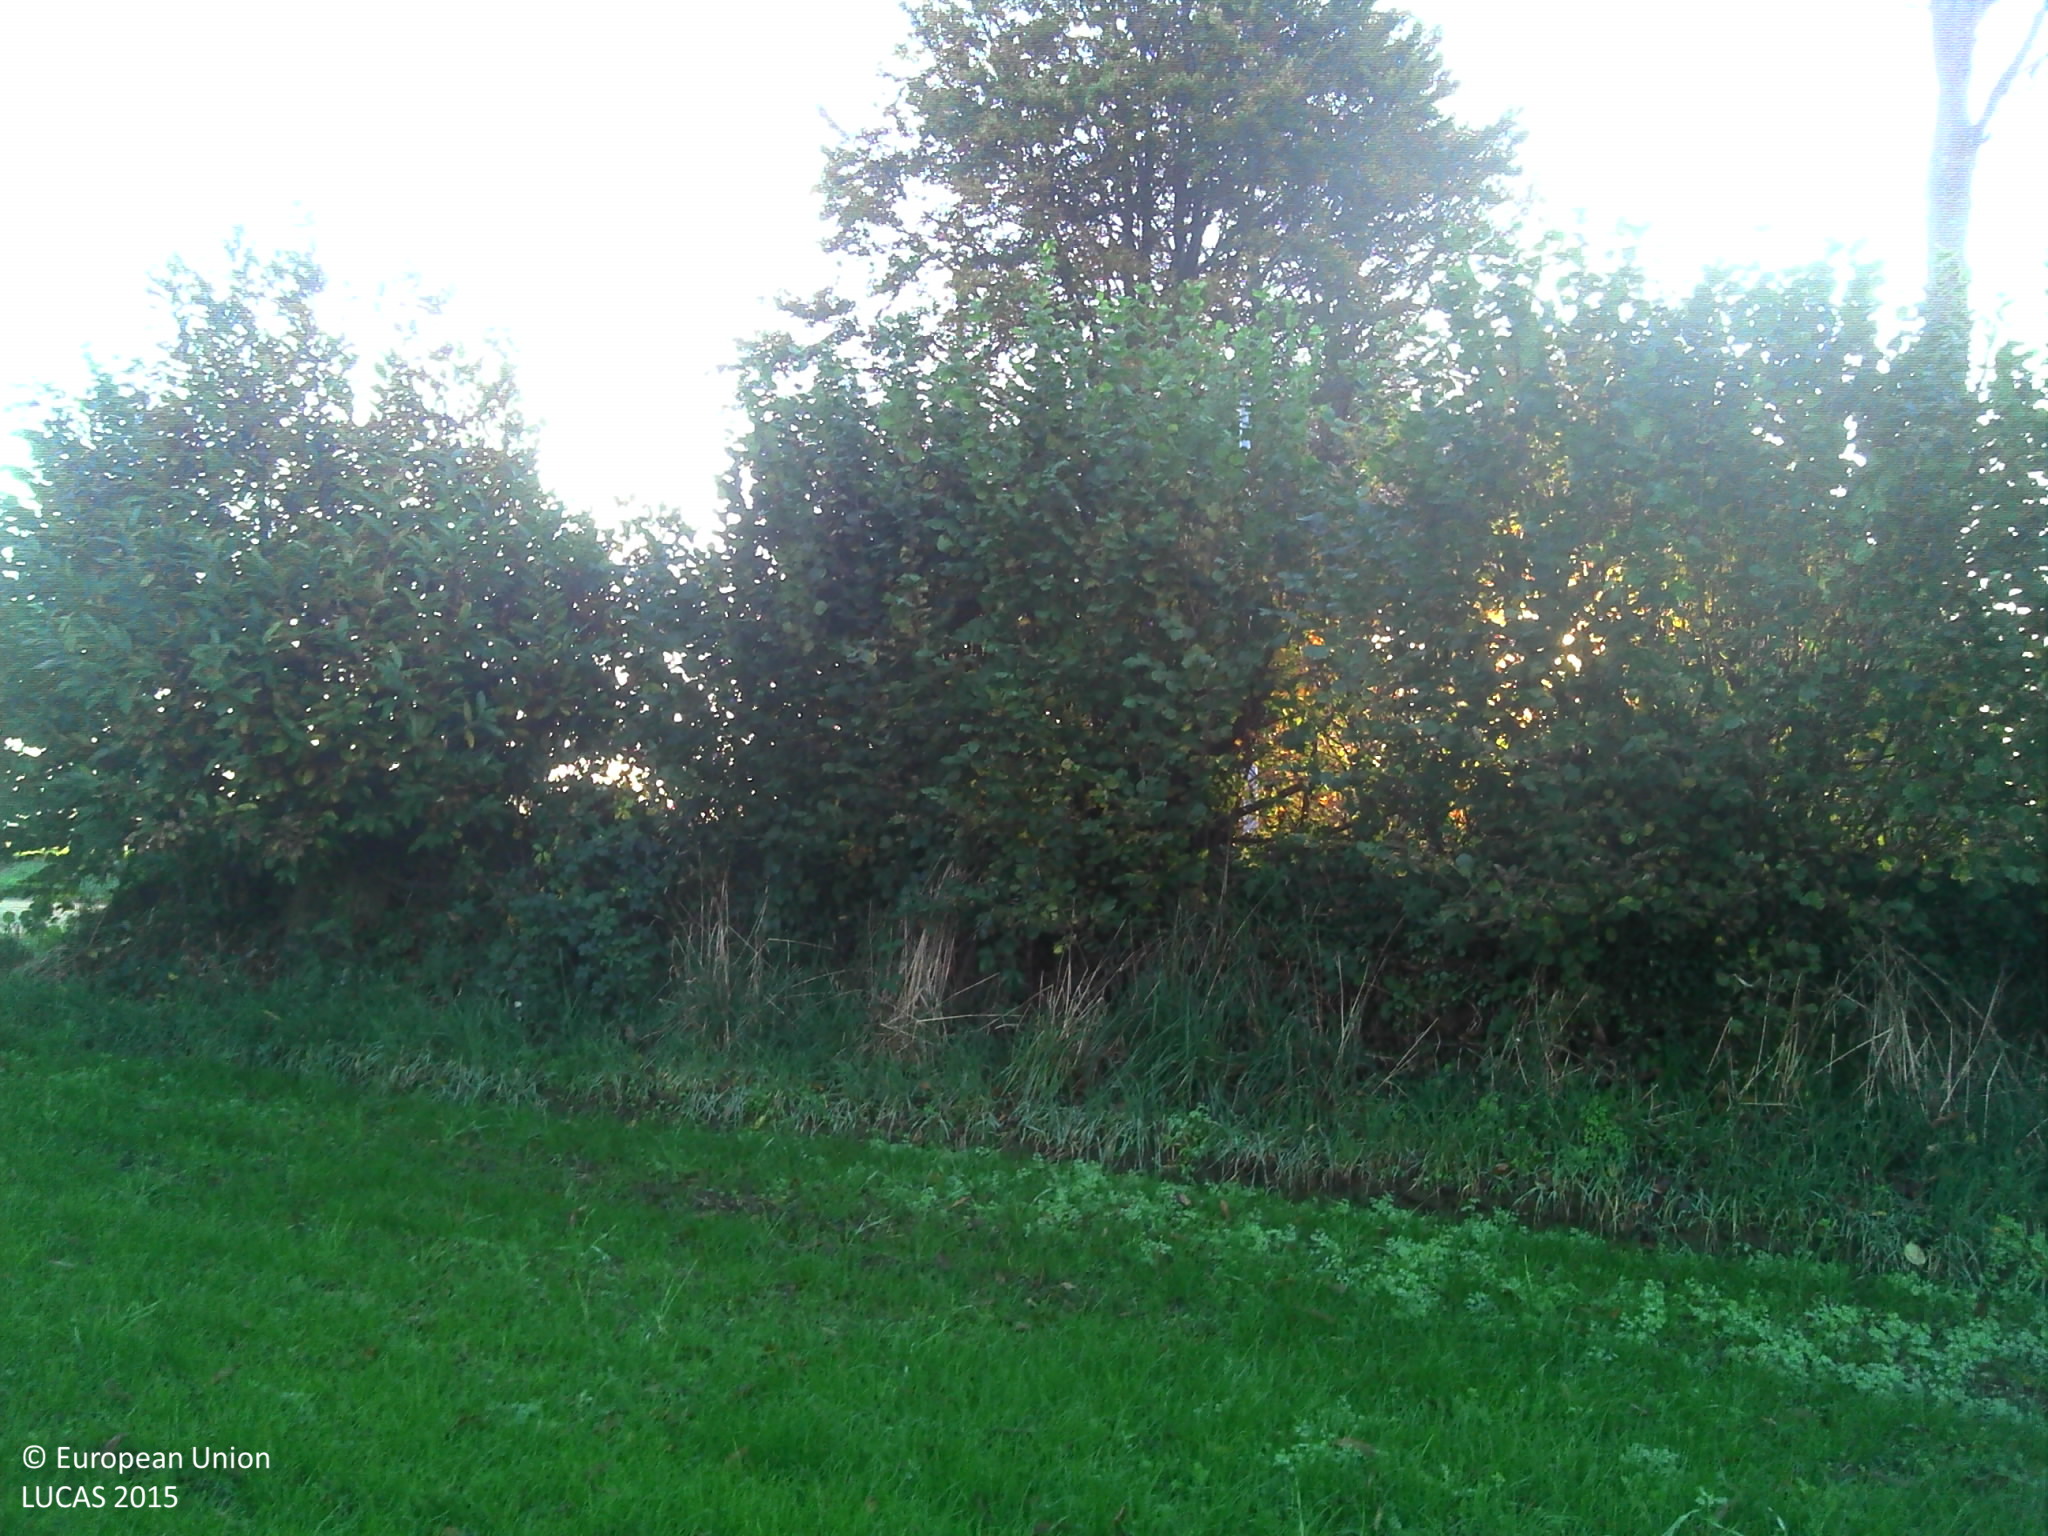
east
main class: Cropland
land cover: Temporary grasslands
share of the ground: > 75 %
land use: Agriculture (excluding fallow land and kitchen gardens)
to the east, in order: Temporary grasslands; Ditches and canals; Abandoned hedges; Grass margins; Paved roads, cycling and walking lanes; Grass margins; Electric lines; Temporary grasslands; Fences; Abandoned hedges; Fences; Grassland without tree/shrub cover
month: November
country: FR
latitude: 48.1053
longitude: -3.6030
